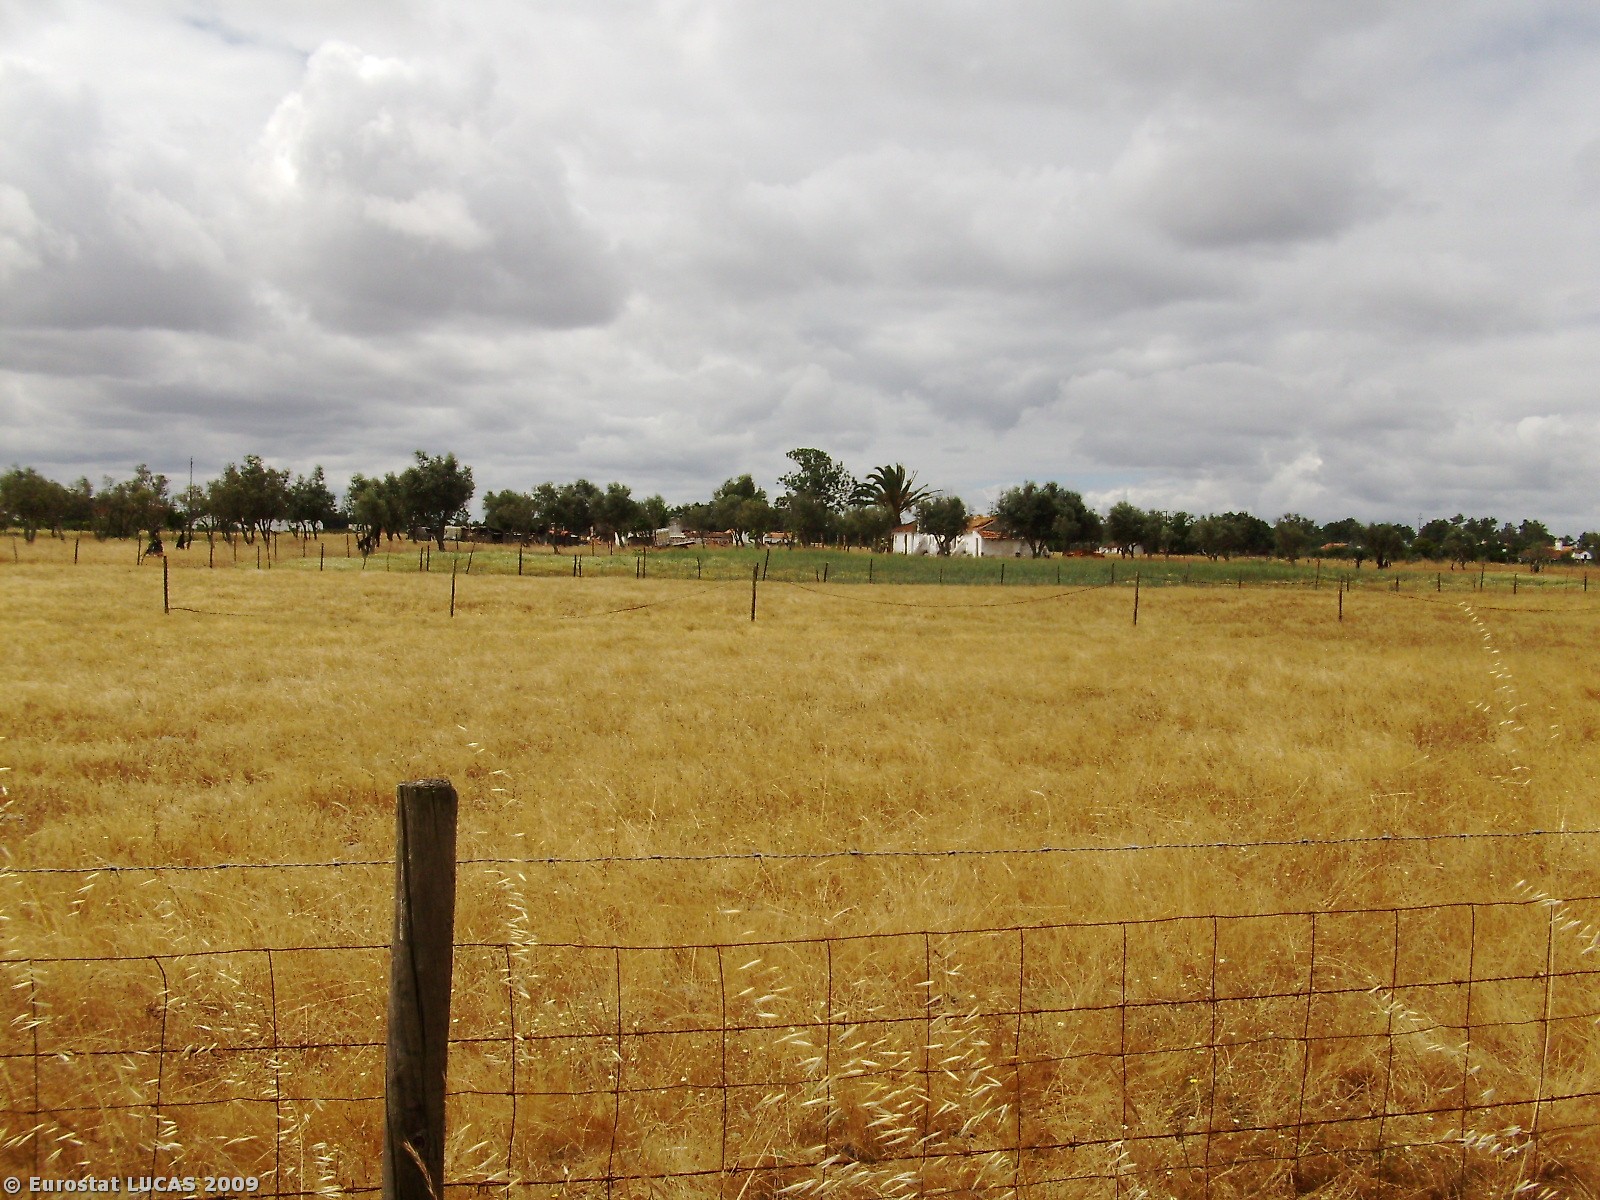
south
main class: Grassland
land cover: Spontaneously vegetated surfaces
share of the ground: > 75 %
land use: Fallow land
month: June
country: PT
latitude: 38.2187
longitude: -8.5642
